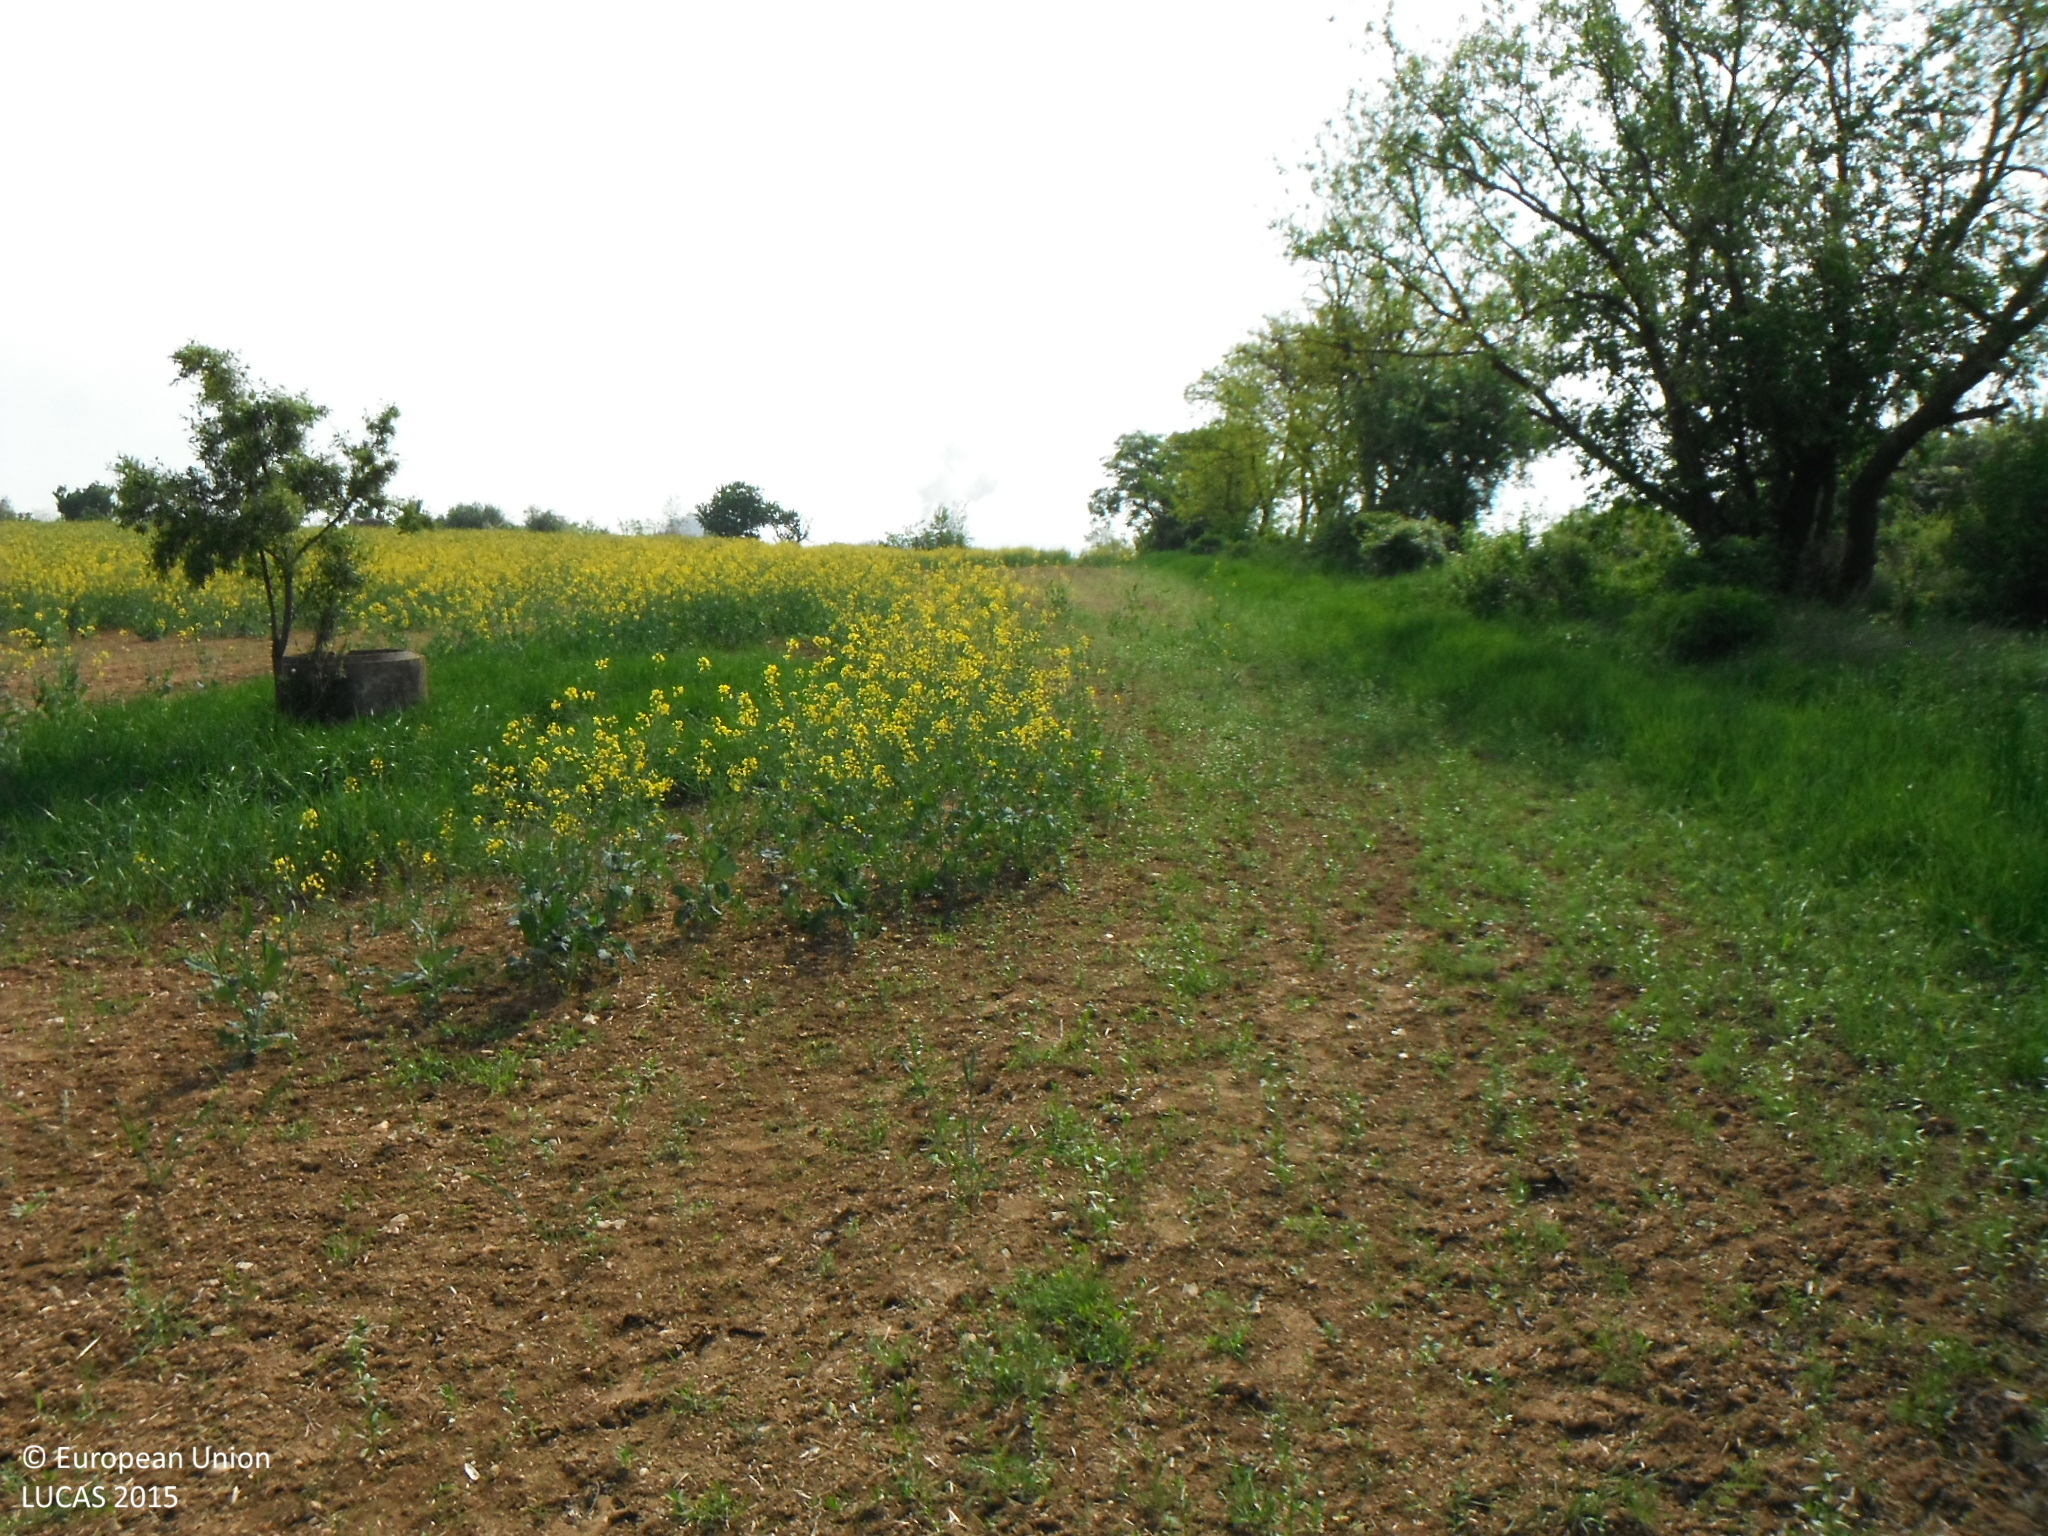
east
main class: Cropland
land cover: Rape and turnip rape
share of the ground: < 10 %
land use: Agriculture (excluding fallow land and kitchen gardens)
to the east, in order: Rape and turnip rape; Tracks; Spontaneously vegetated surfaces; Shrubland without tree cover; Tracks; Shrubland with sparse tree cover; Common wheat
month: May
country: SK
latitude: 48.6005
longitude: 21.1489
